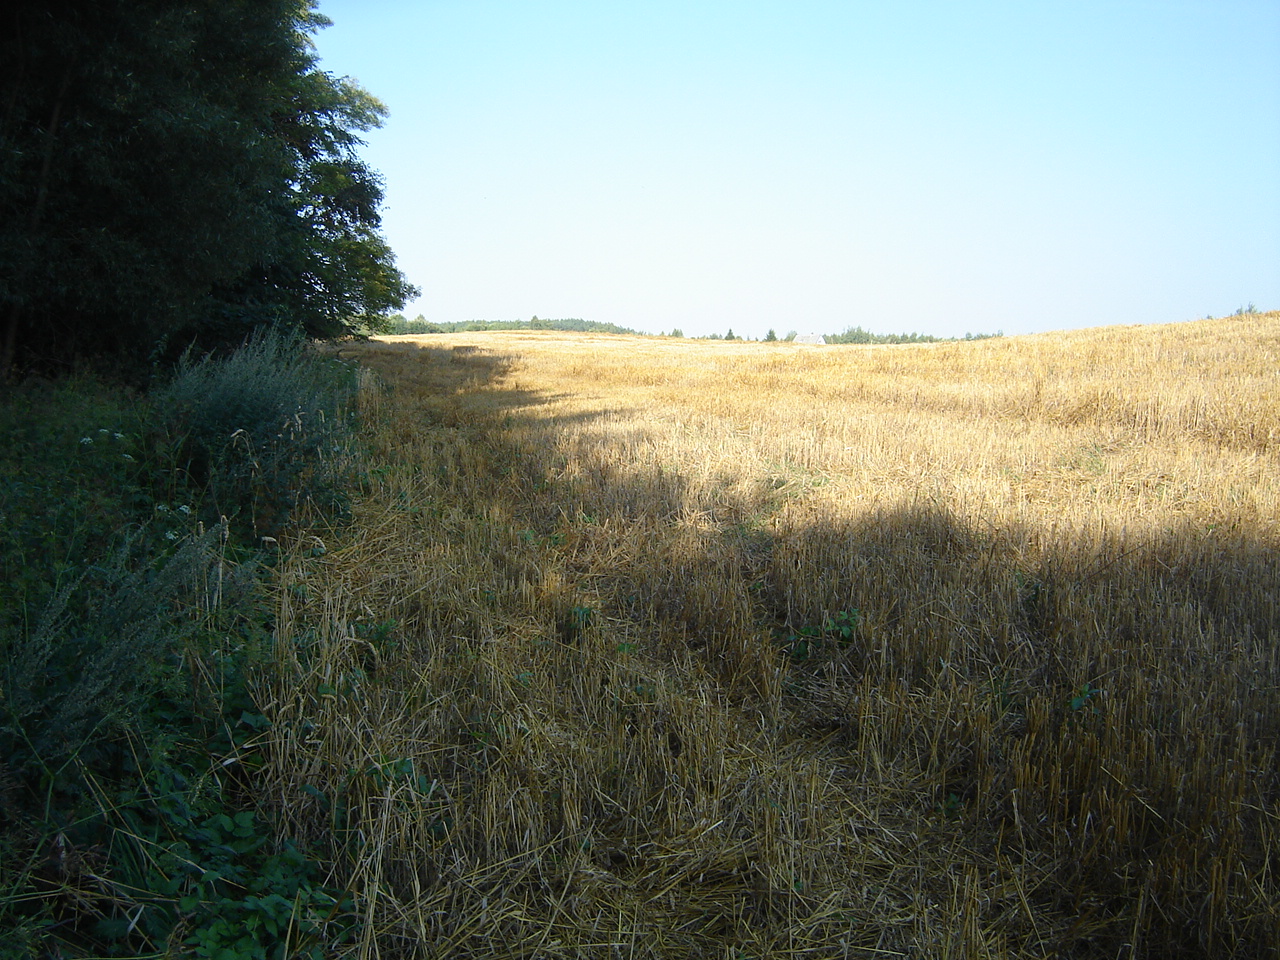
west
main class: Woodland
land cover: Broadleaved woodland
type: non-riverine alder, birch or aspen forest
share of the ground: > 75 %
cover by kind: broadleaved forest trees 90 %, herbaceous plants 10 %
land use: Forestry
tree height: > 5 m
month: August
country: LT
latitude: 54.8610
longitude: 24.8321
